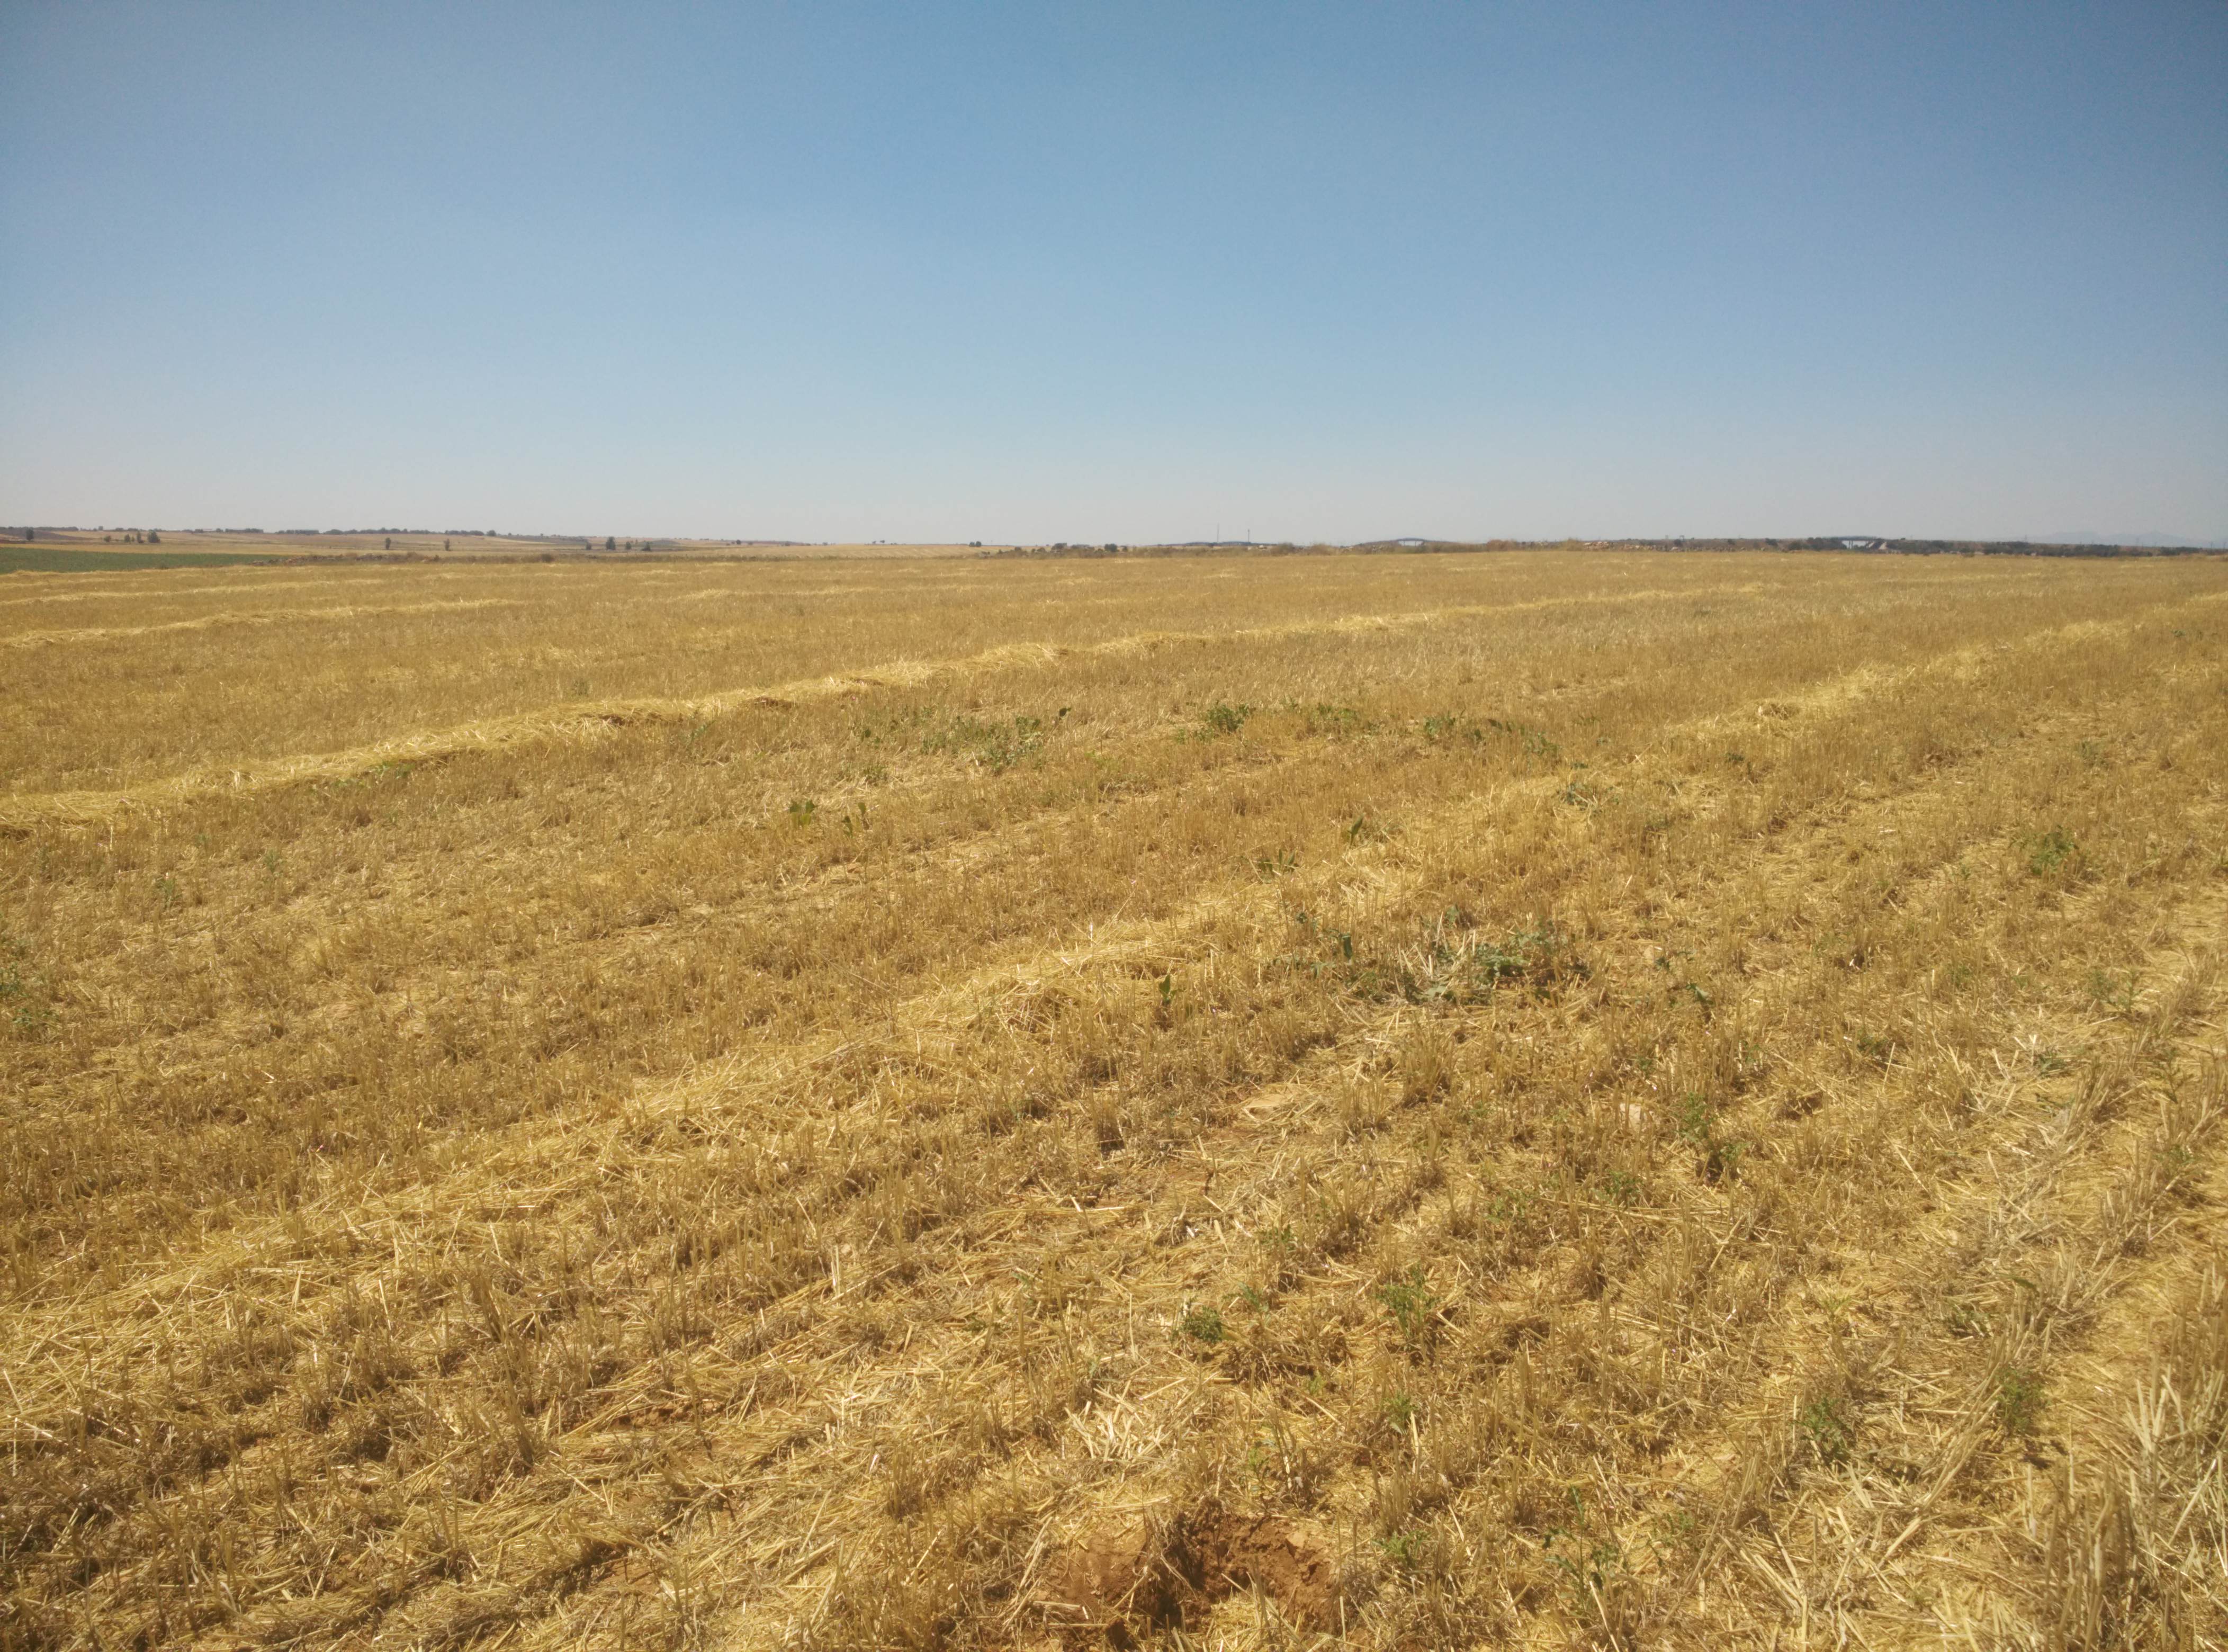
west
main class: Cropland
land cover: Common wheat
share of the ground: < 10 %
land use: Agriculture (excluding fallow land and kitchen gardens)
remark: Harvested field
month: July
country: ES
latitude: 40.8807
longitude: -2.7170
